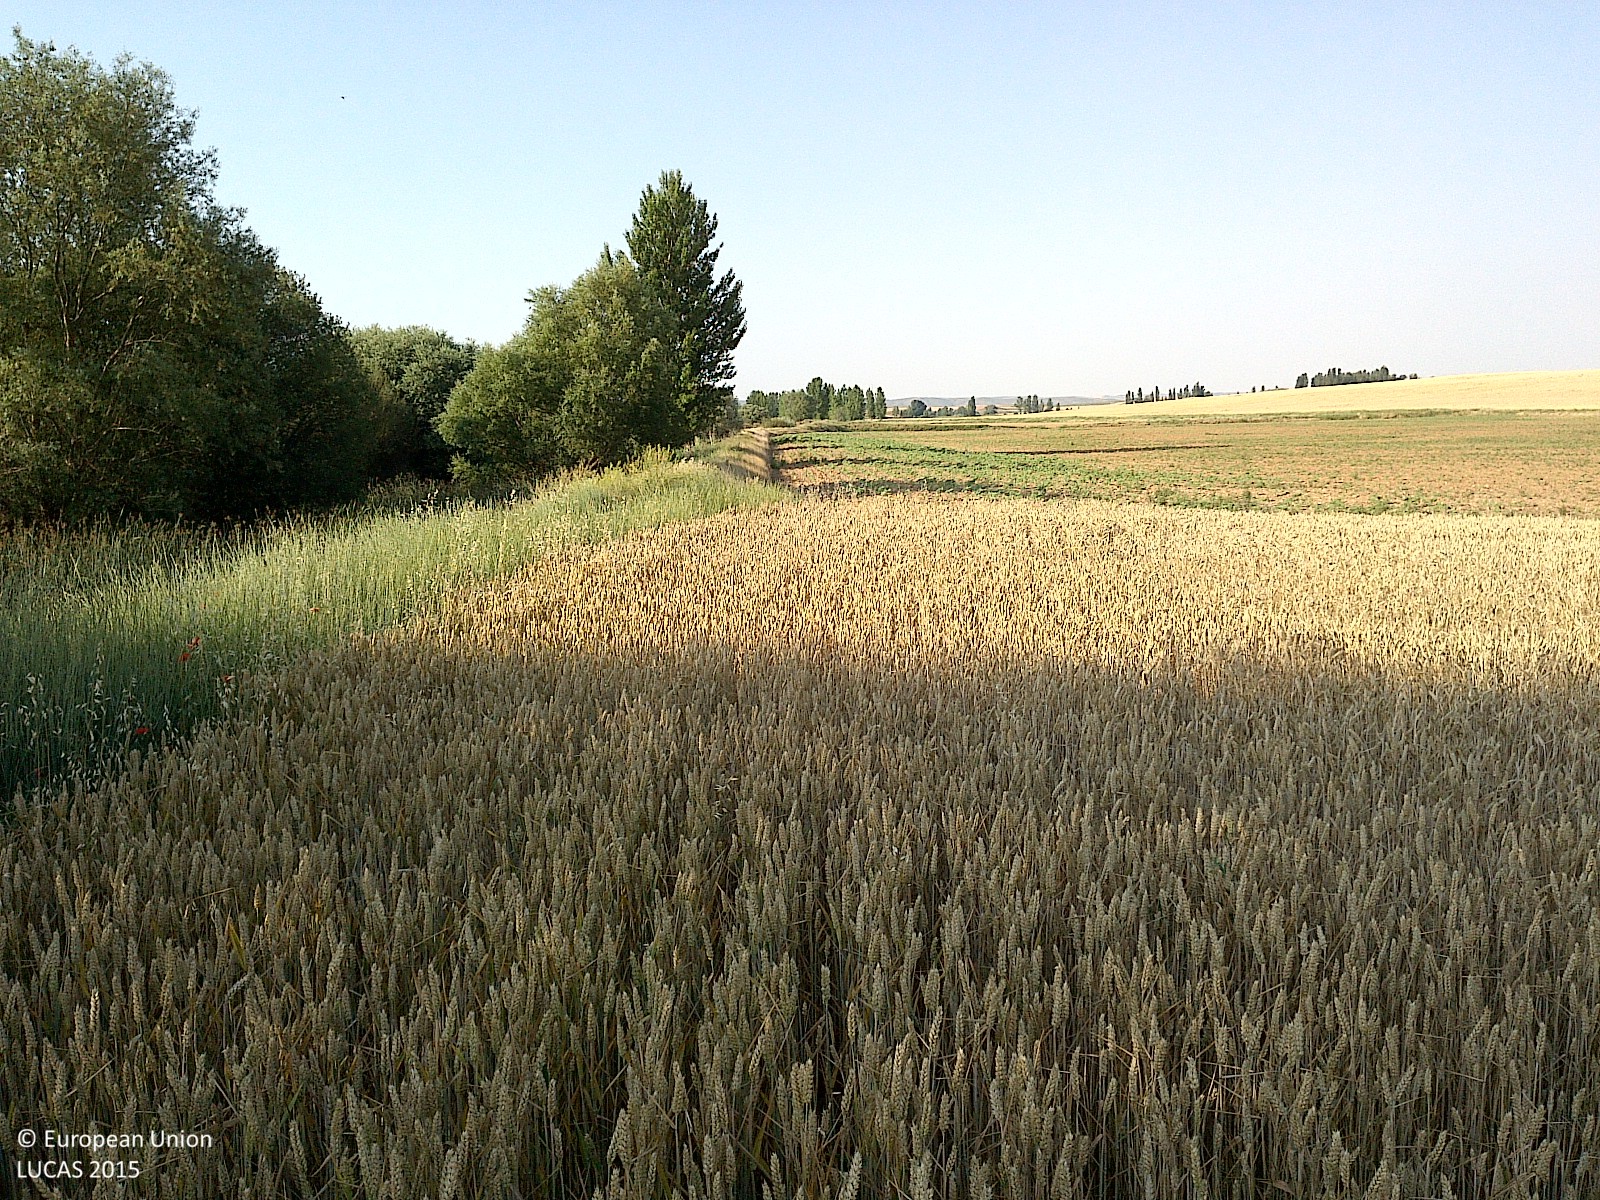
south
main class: Cropland
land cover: Common wheat
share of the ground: > 75 %
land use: Agriculture (excluding fallow land and kitchen gardens)
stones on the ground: < 10 %
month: June
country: ES
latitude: 41.6495
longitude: -2.2698
